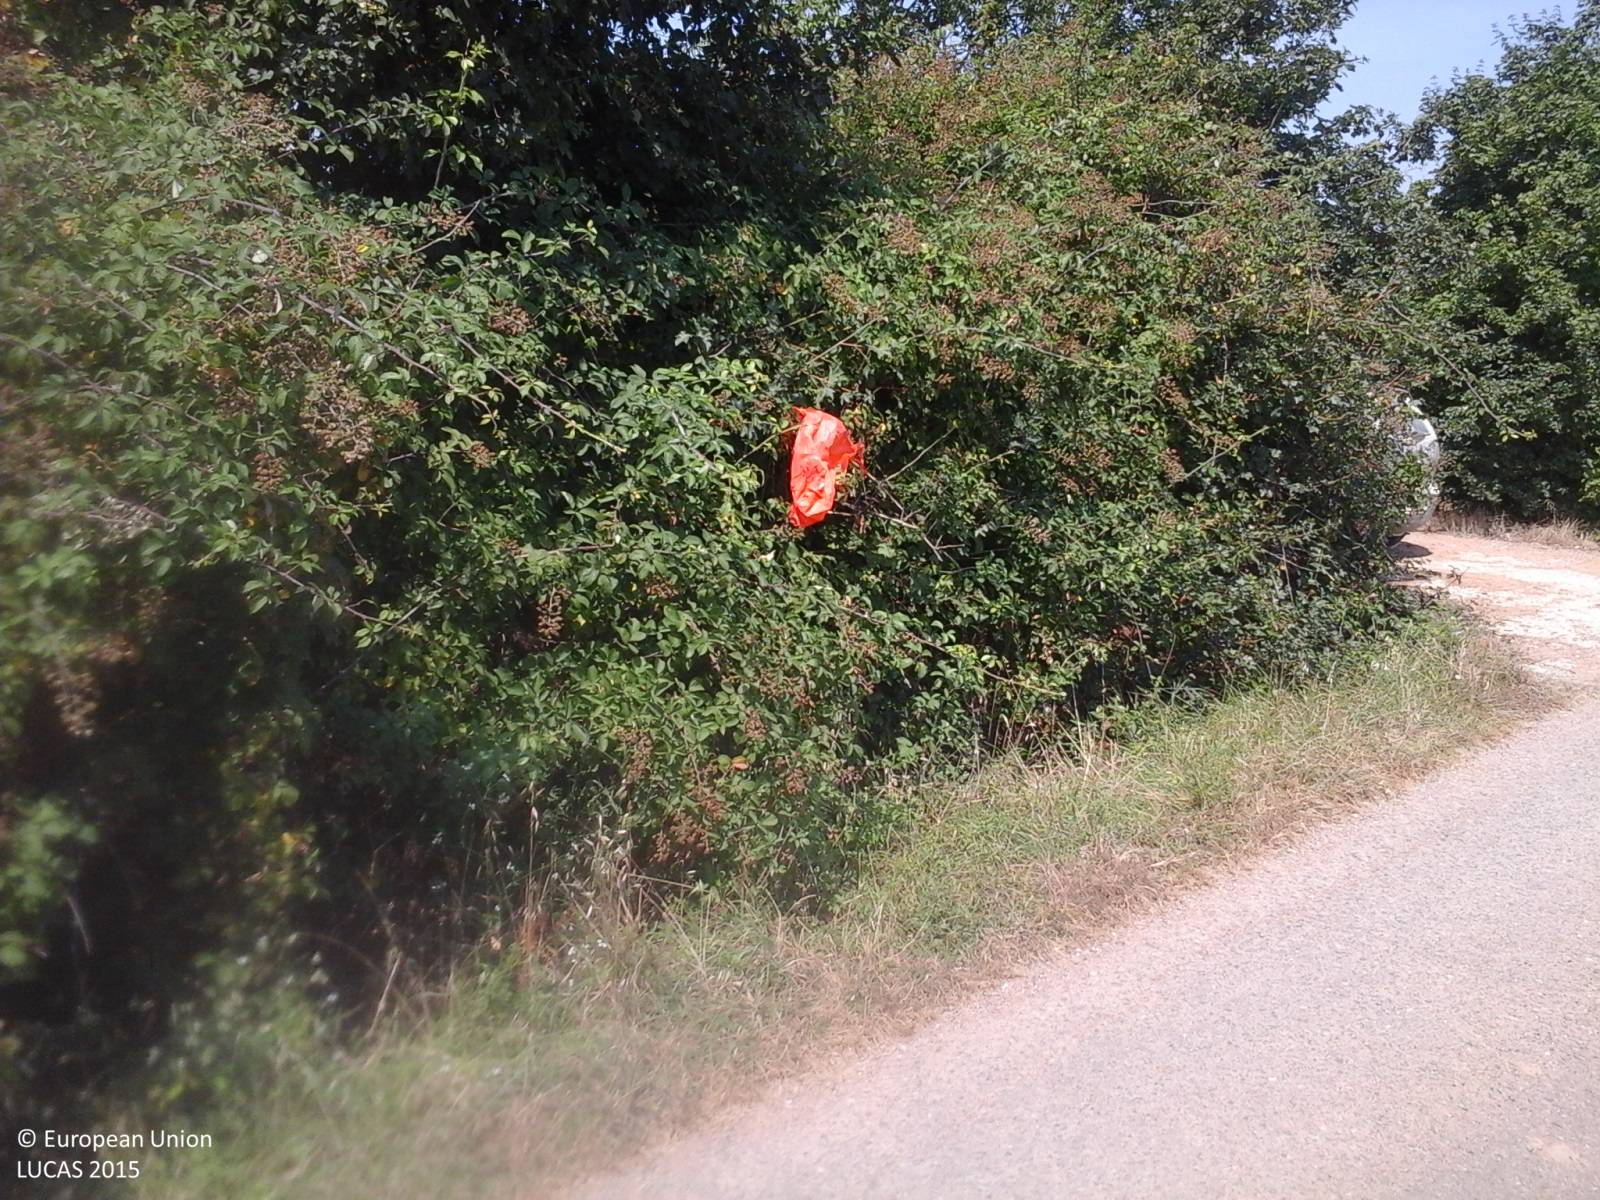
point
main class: Shrubland
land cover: Shrubland with sparse tree cover
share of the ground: 50 - 75 %
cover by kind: shrubs 95 %, broadleaved forest trees 5 %
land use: Abandoned areas
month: July
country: IT
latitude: 43.3048
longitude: 11.8808
